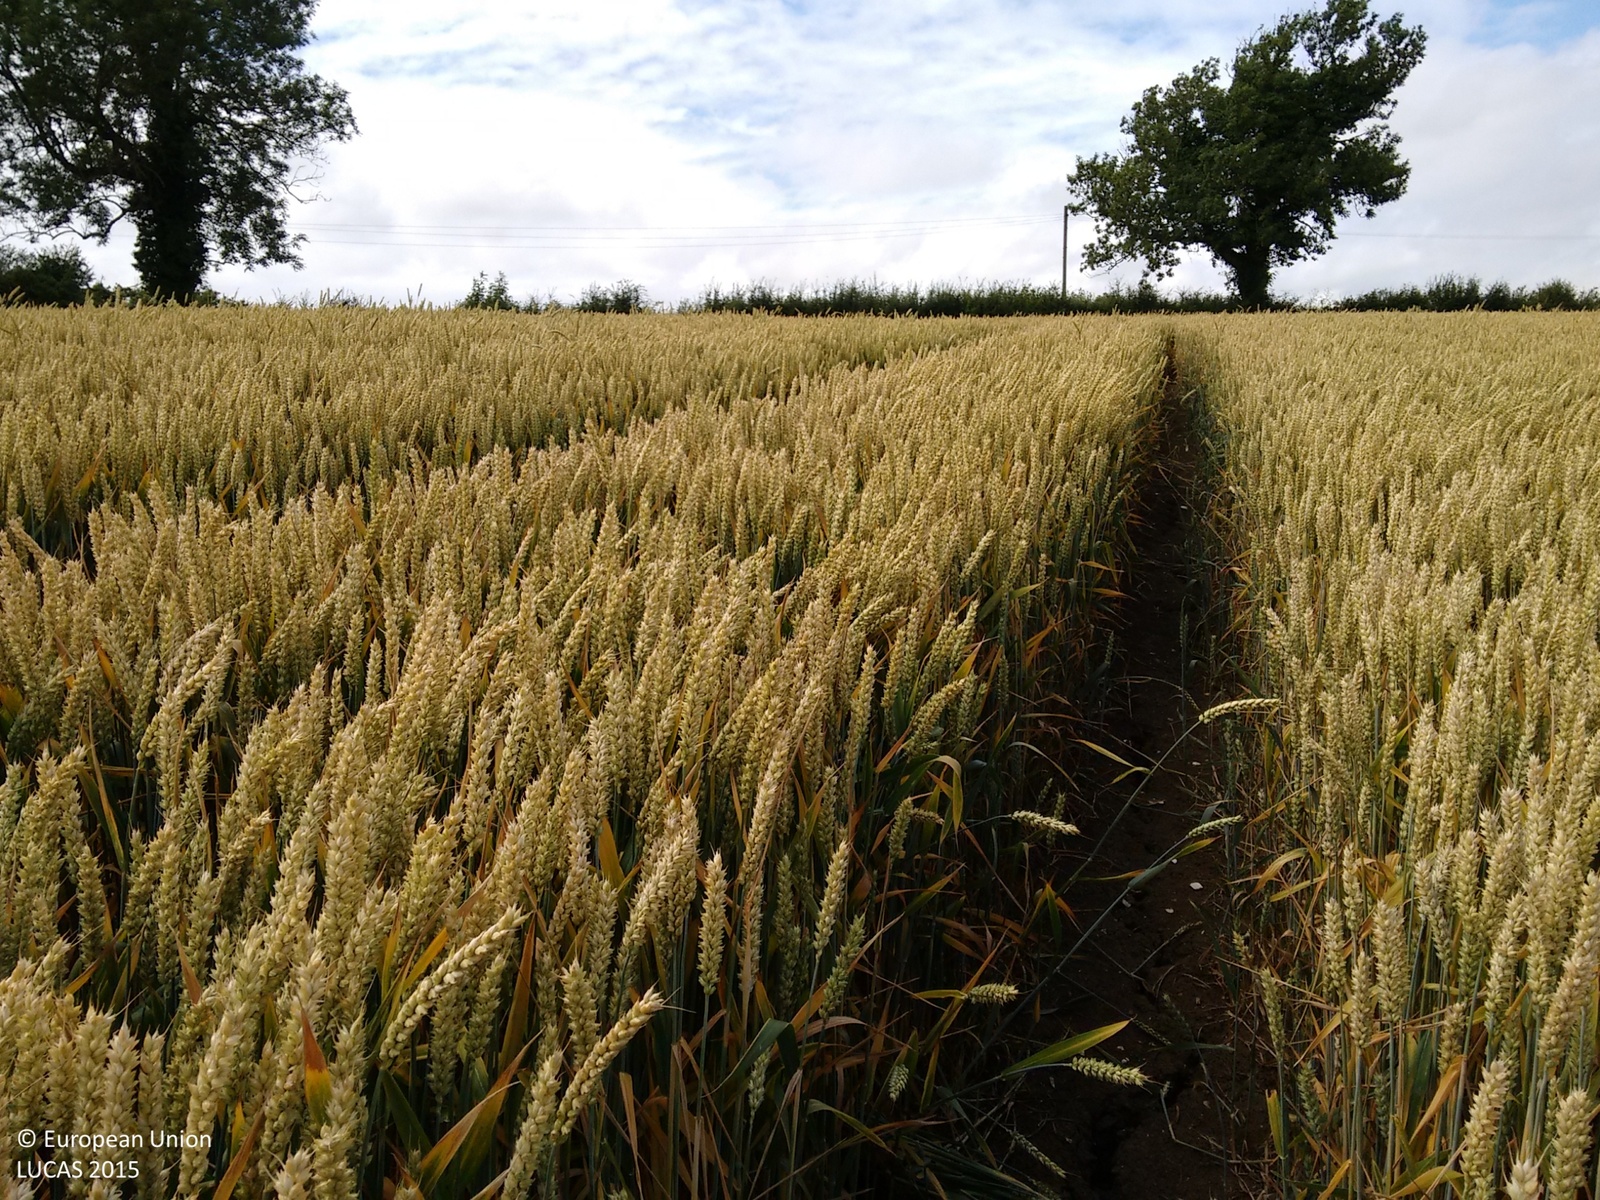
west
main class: Cropland
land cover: Common wheat
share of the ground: > 75 %
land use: Agriculture (excluding fallow land and kitchen gardens)
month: July
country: GB
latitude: 52.4584
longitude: -0.8593
